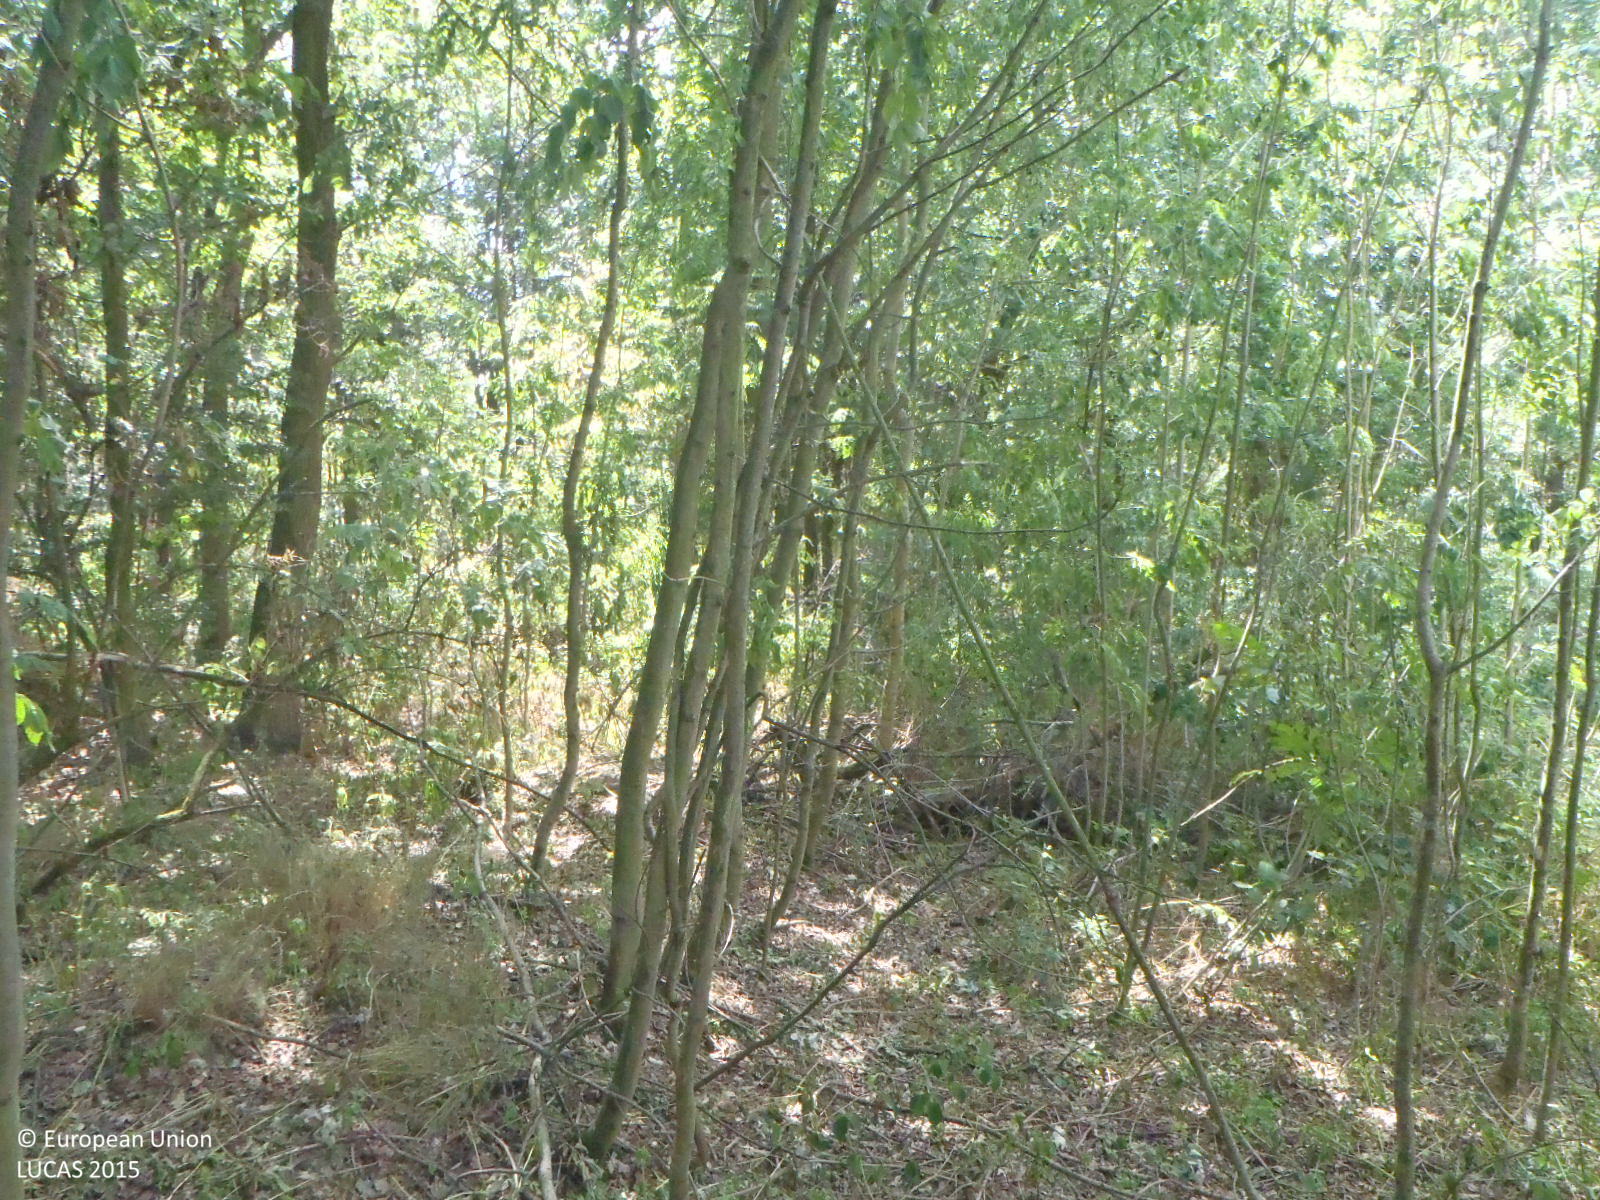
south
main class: Woodland
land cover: Broadleaved woodland
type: mesophytic deciduous forest
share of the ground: > 75 %
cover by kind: broadleaved forest trees 95 %, shrubs 5 %
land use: Forestry
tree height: > 5 m
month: July
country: CZ
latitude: 49.0337
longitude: 14.4739
